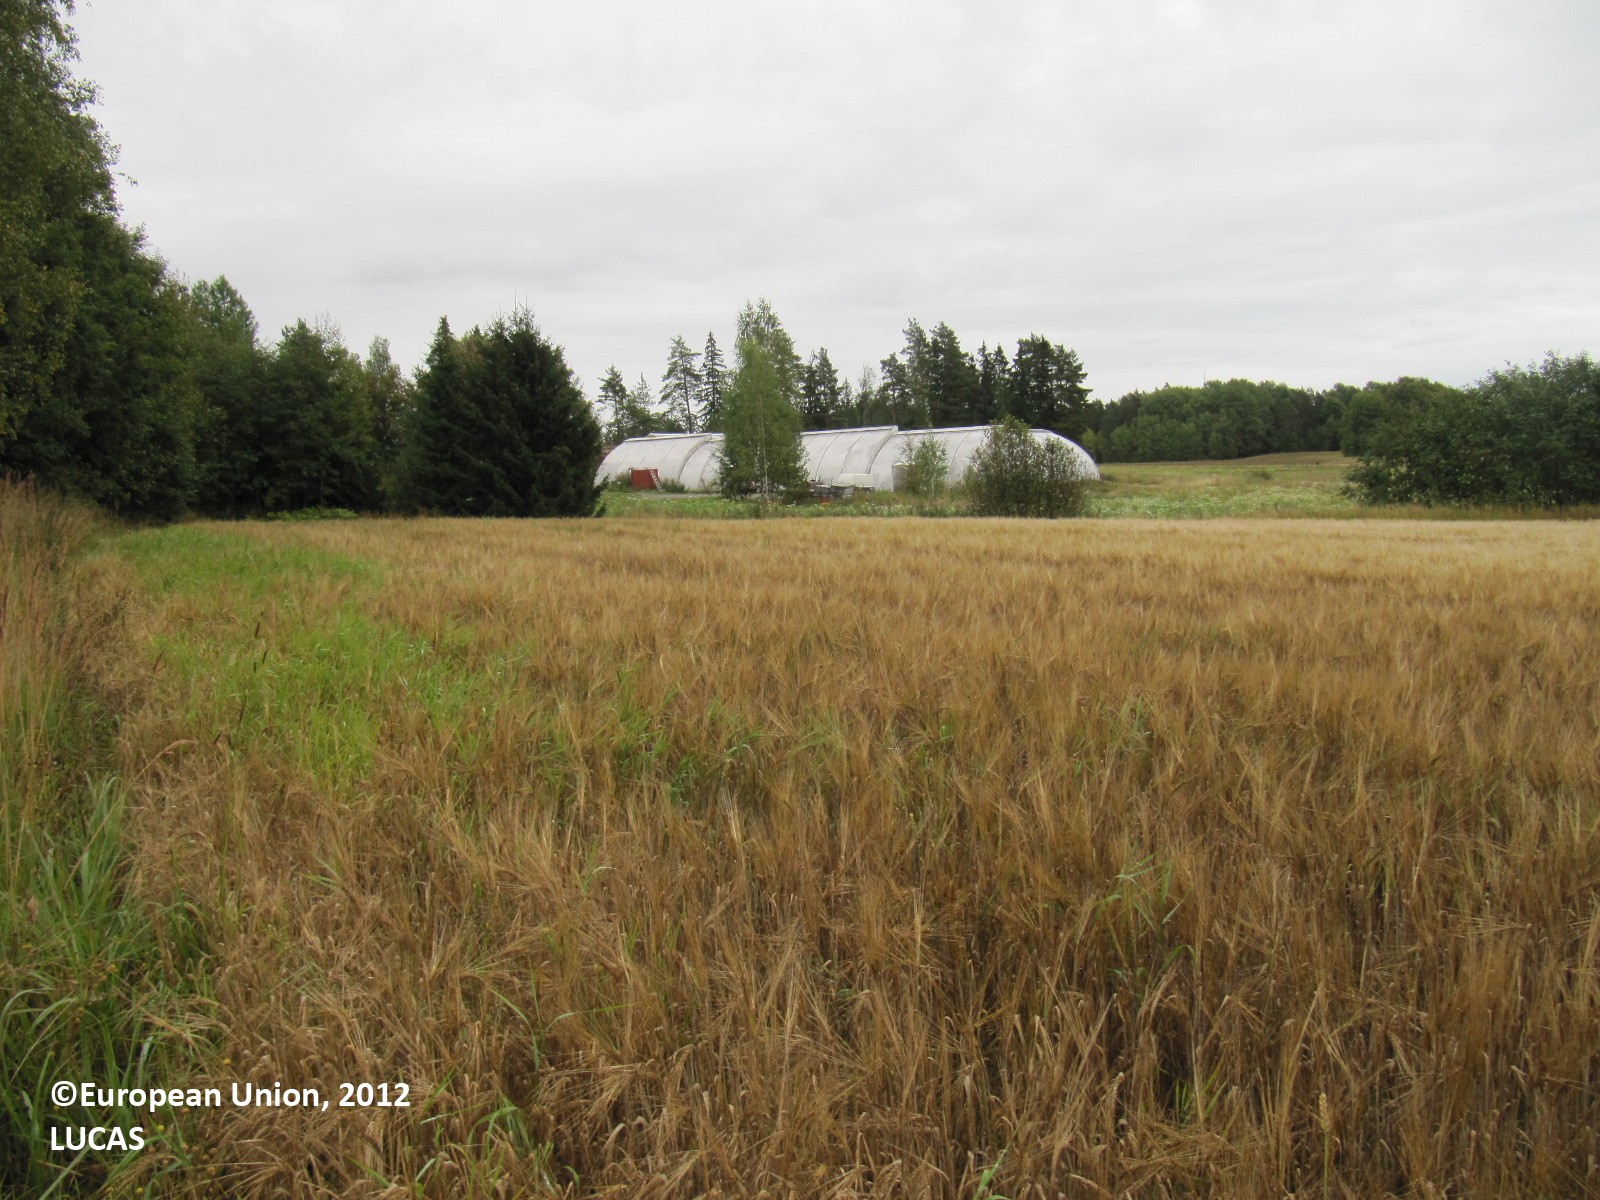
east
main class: Cropland
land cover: Barley
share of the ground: > 75 %
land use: Agriculture (excluding fallow land and kitchen gardens)
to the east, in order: Barley; Spontaneously vegetated surfaces; Ditches and canals; Broadleaved woodland; Spontaneously vegetated surfaces; Tracks; Spontaneously vegetated surfaces; Ditches and canals; Spontaneously vegetated surfaces
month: September
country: FI
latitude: 60.0583
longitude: 24.0566
